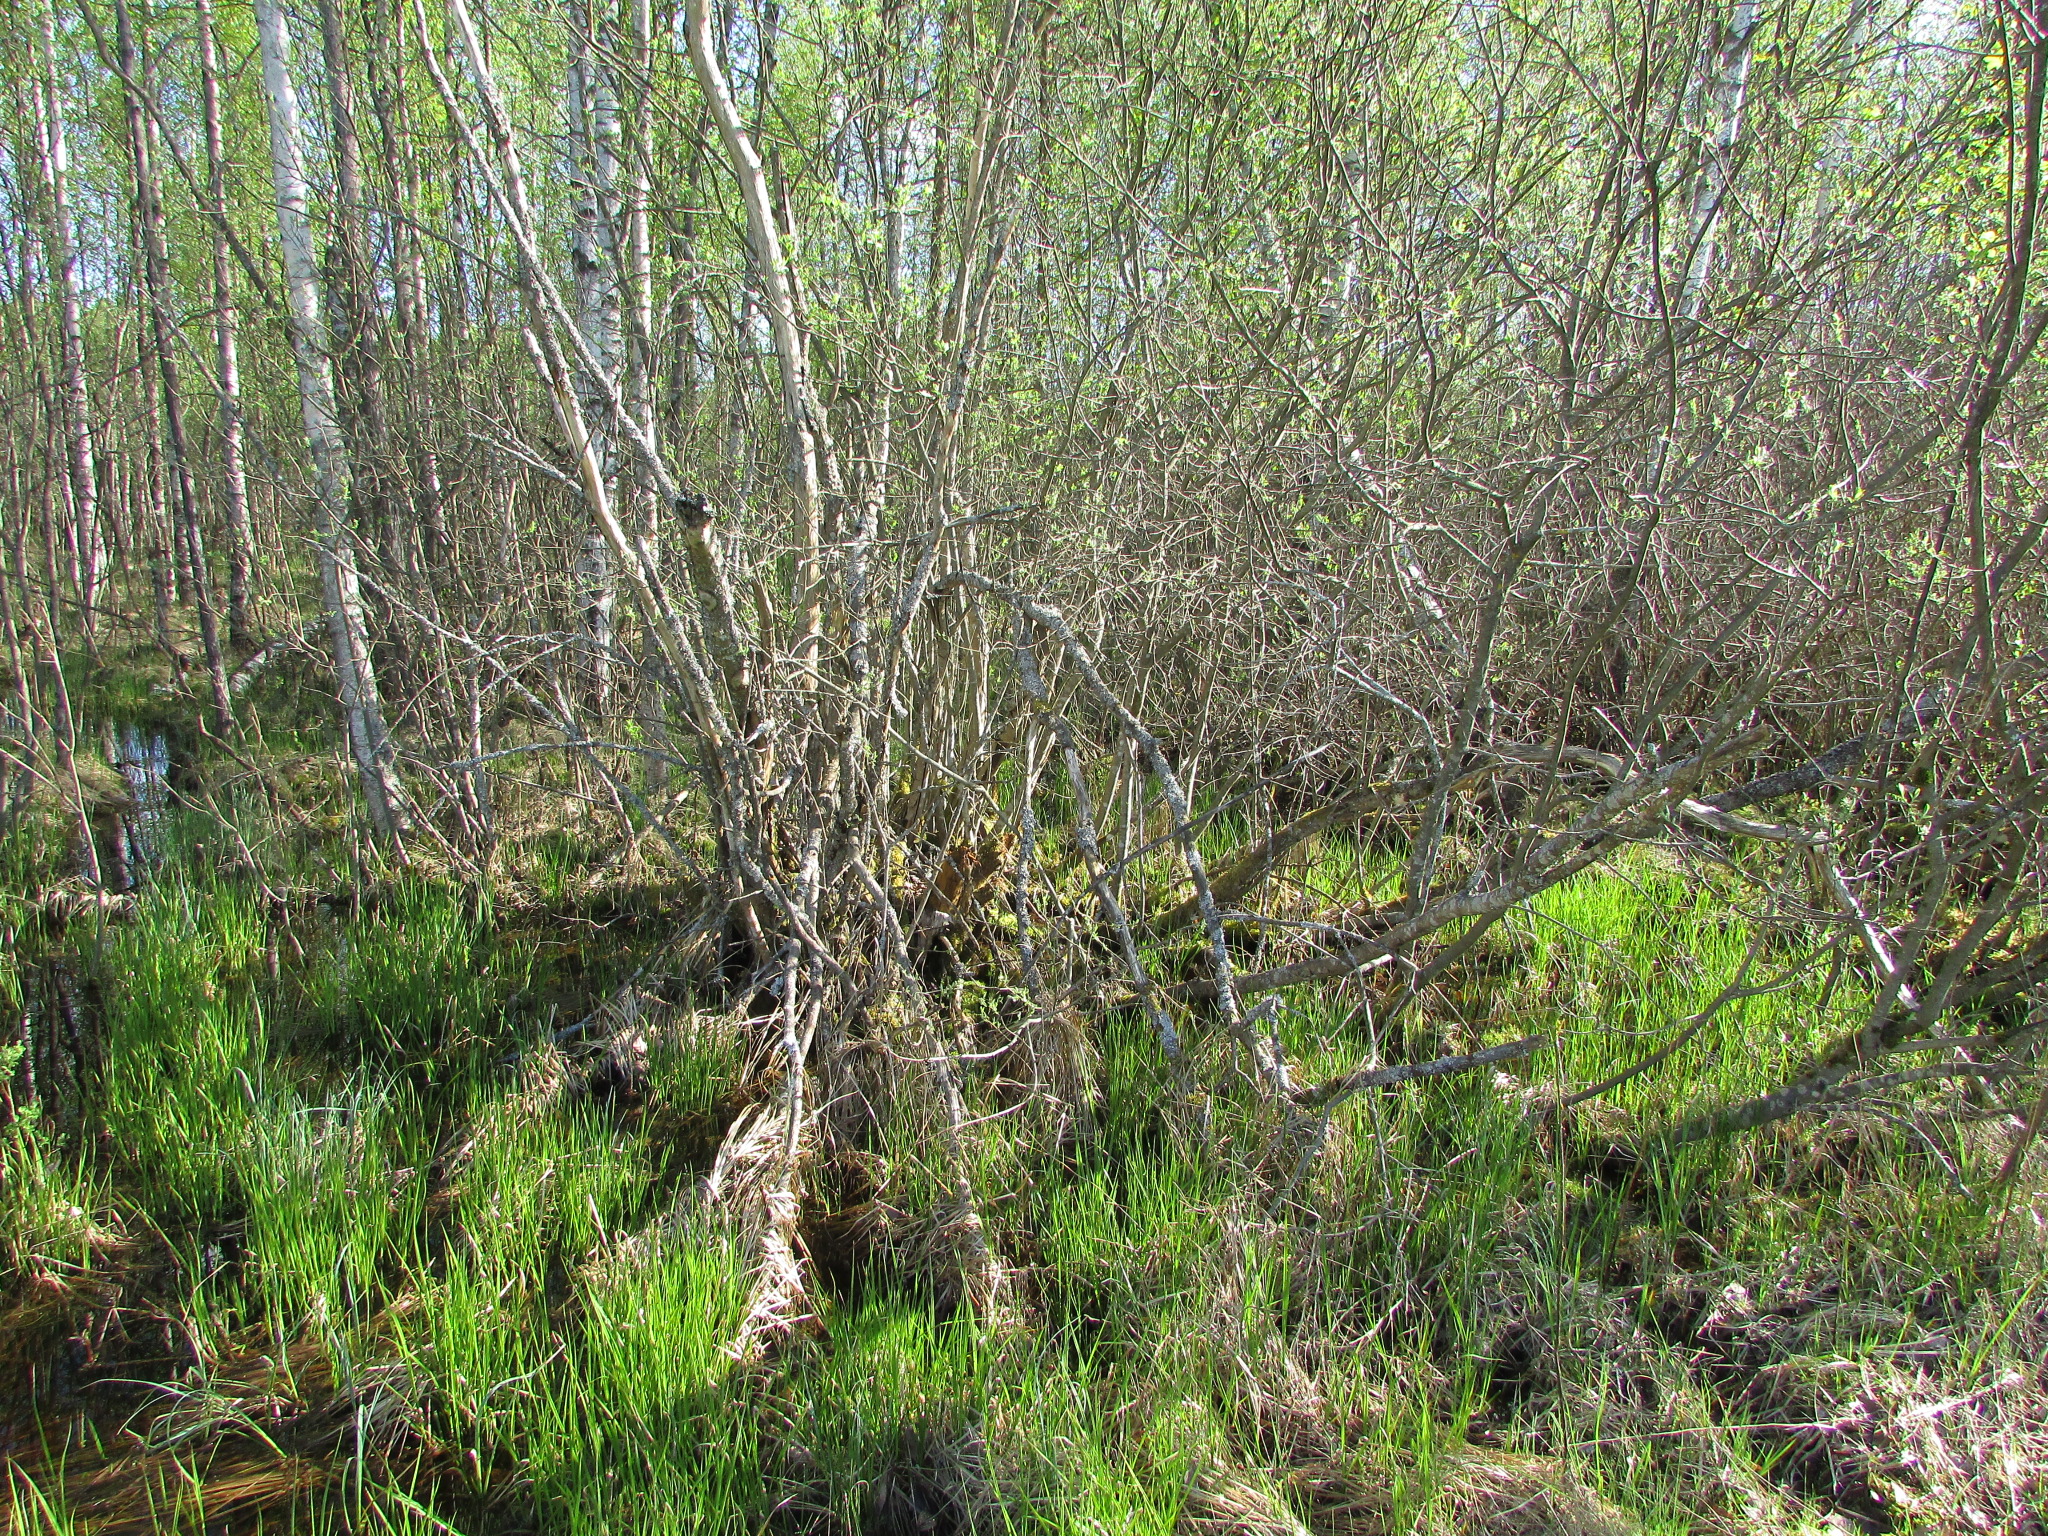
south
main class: Woodland
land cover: Broadleaved woodland
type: non-riverine alder, birch or aspen forest
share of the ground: > 75 %
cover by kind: broadleaved forest trees 100 %
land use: Semi-natural and natural areas not in use
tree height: > 5 m
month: May
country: LV
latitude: 56.1270
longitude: 27.1418
